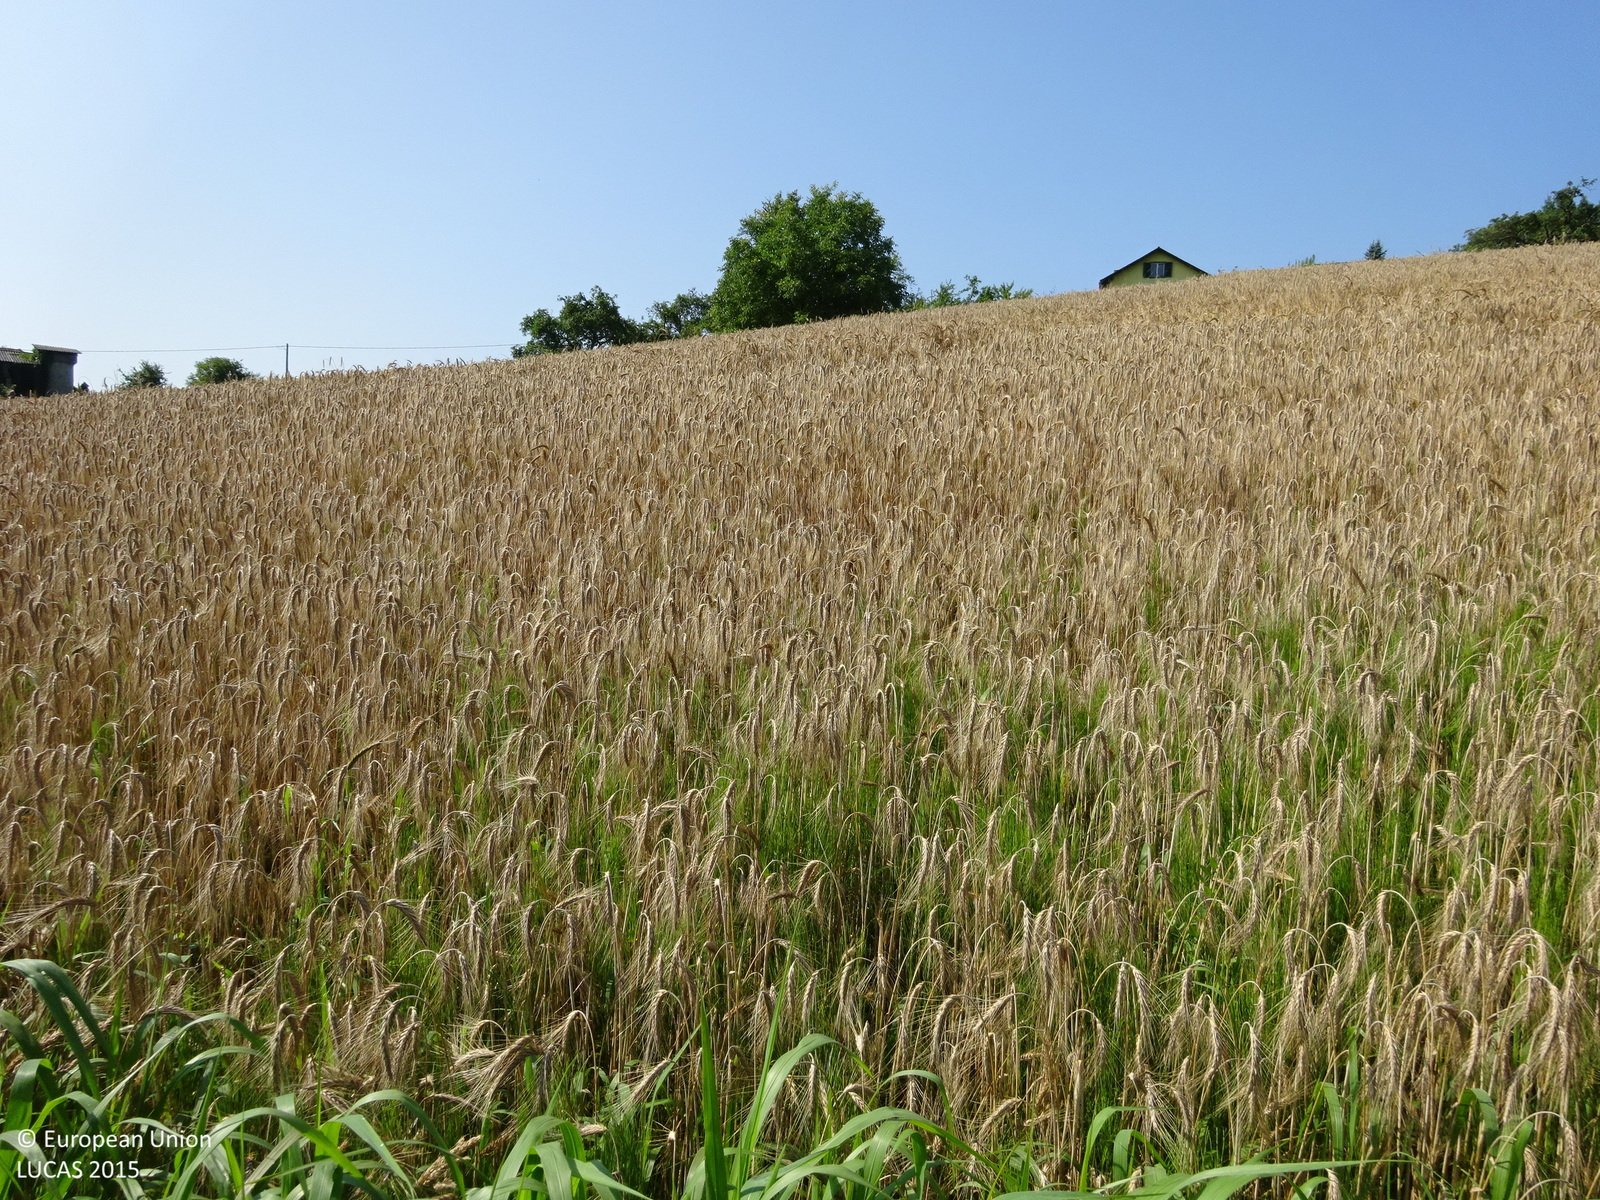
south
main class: Cropland
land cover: Barley
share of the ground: > 75 %
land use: Agriculture (excluding fallow land and kitchen gardens)
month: July
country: AT
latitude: 46.8252
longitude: 15.4656
